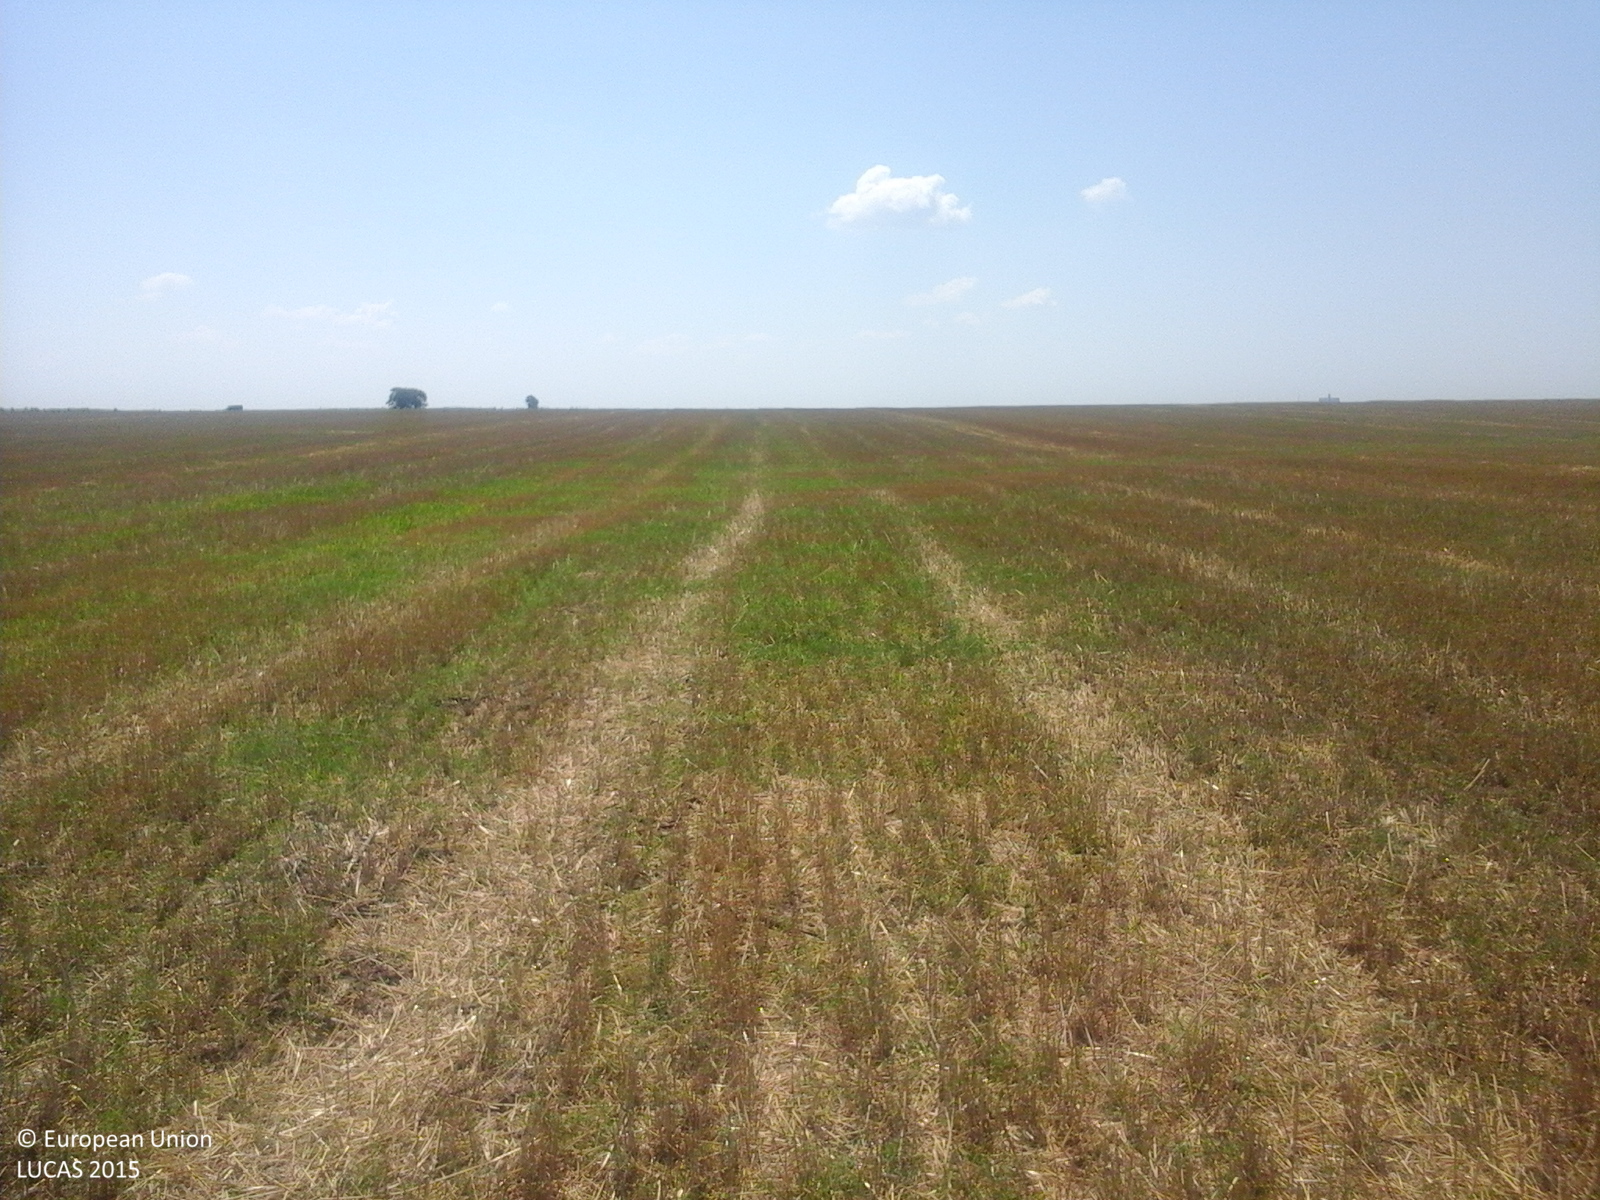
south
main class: Cropland
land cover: Common wheat
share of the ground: < 10 %
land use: Agriculture (excluding fallow land and kitchen gardens)
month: July
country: RO
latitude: 44.1802
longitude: 24.6692
